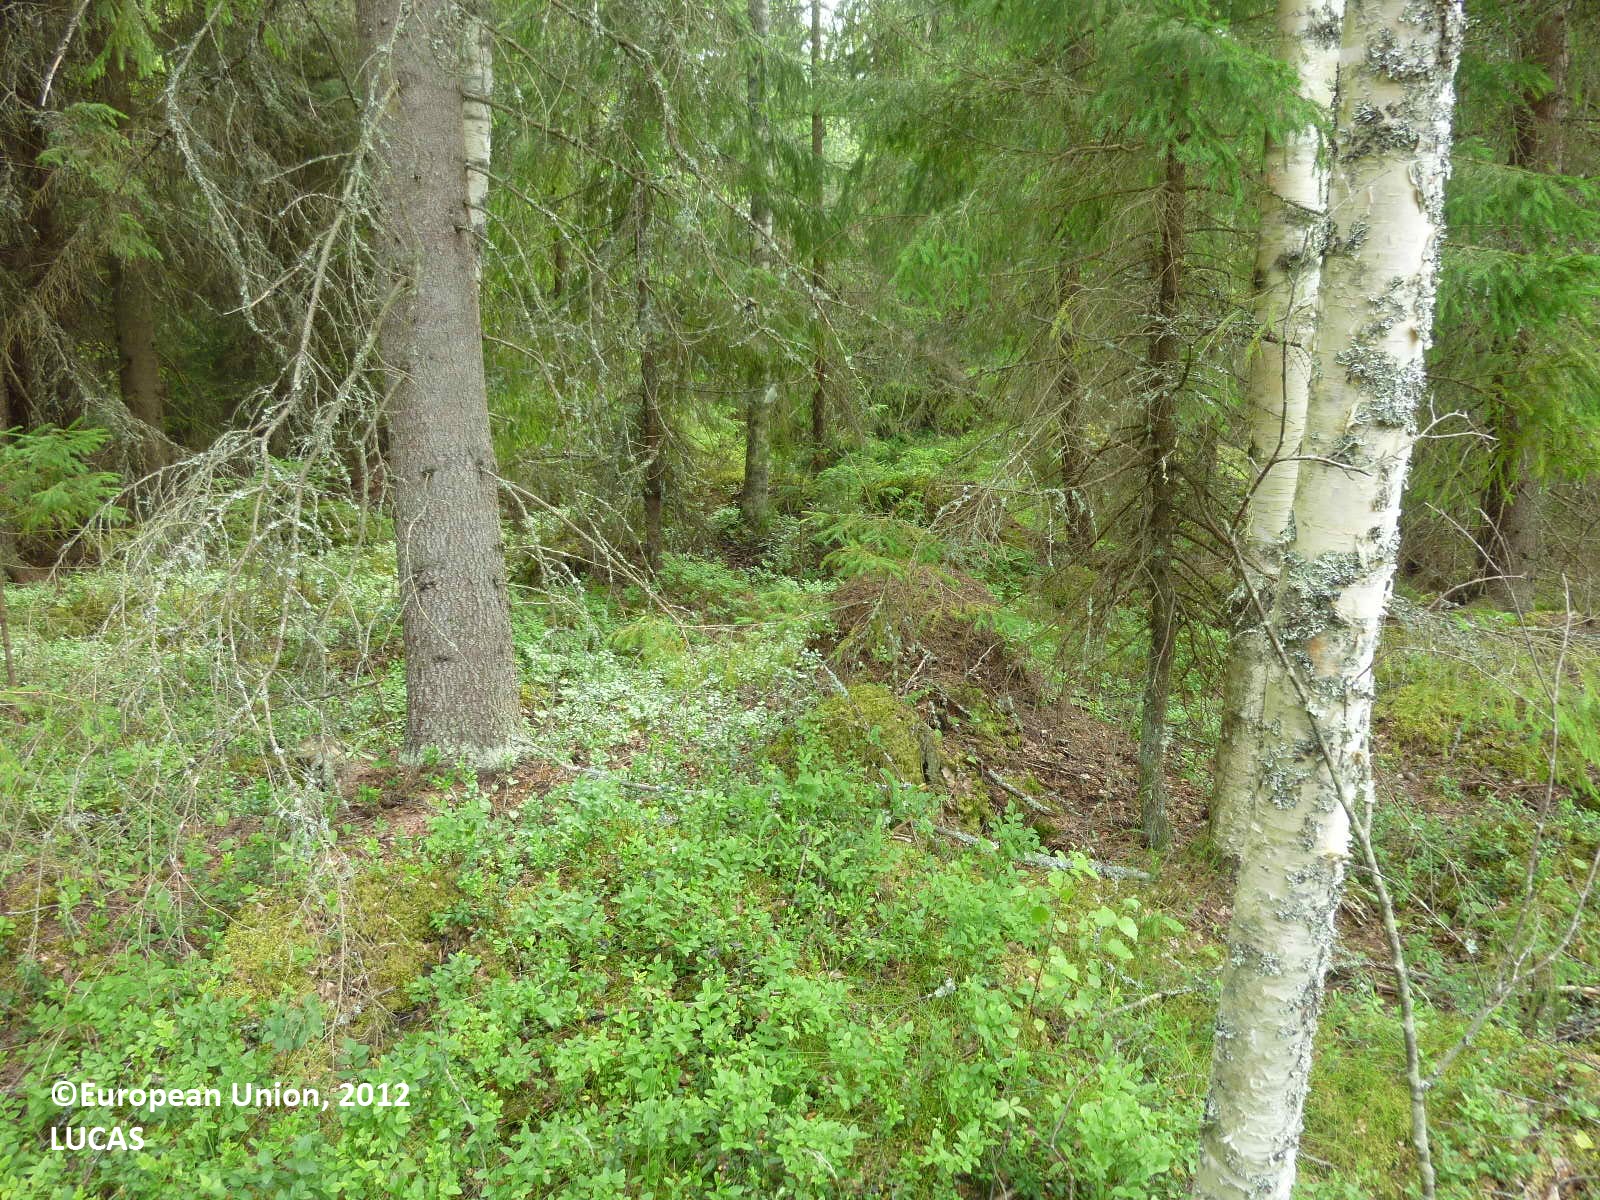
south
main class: Woodland
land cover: Spruce dominated mixed woodland
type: boreal forest
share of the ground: > 75 %
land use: Forestry
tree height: > 5 m
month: July
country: FI
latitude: 61.1375
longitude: 22.7161
